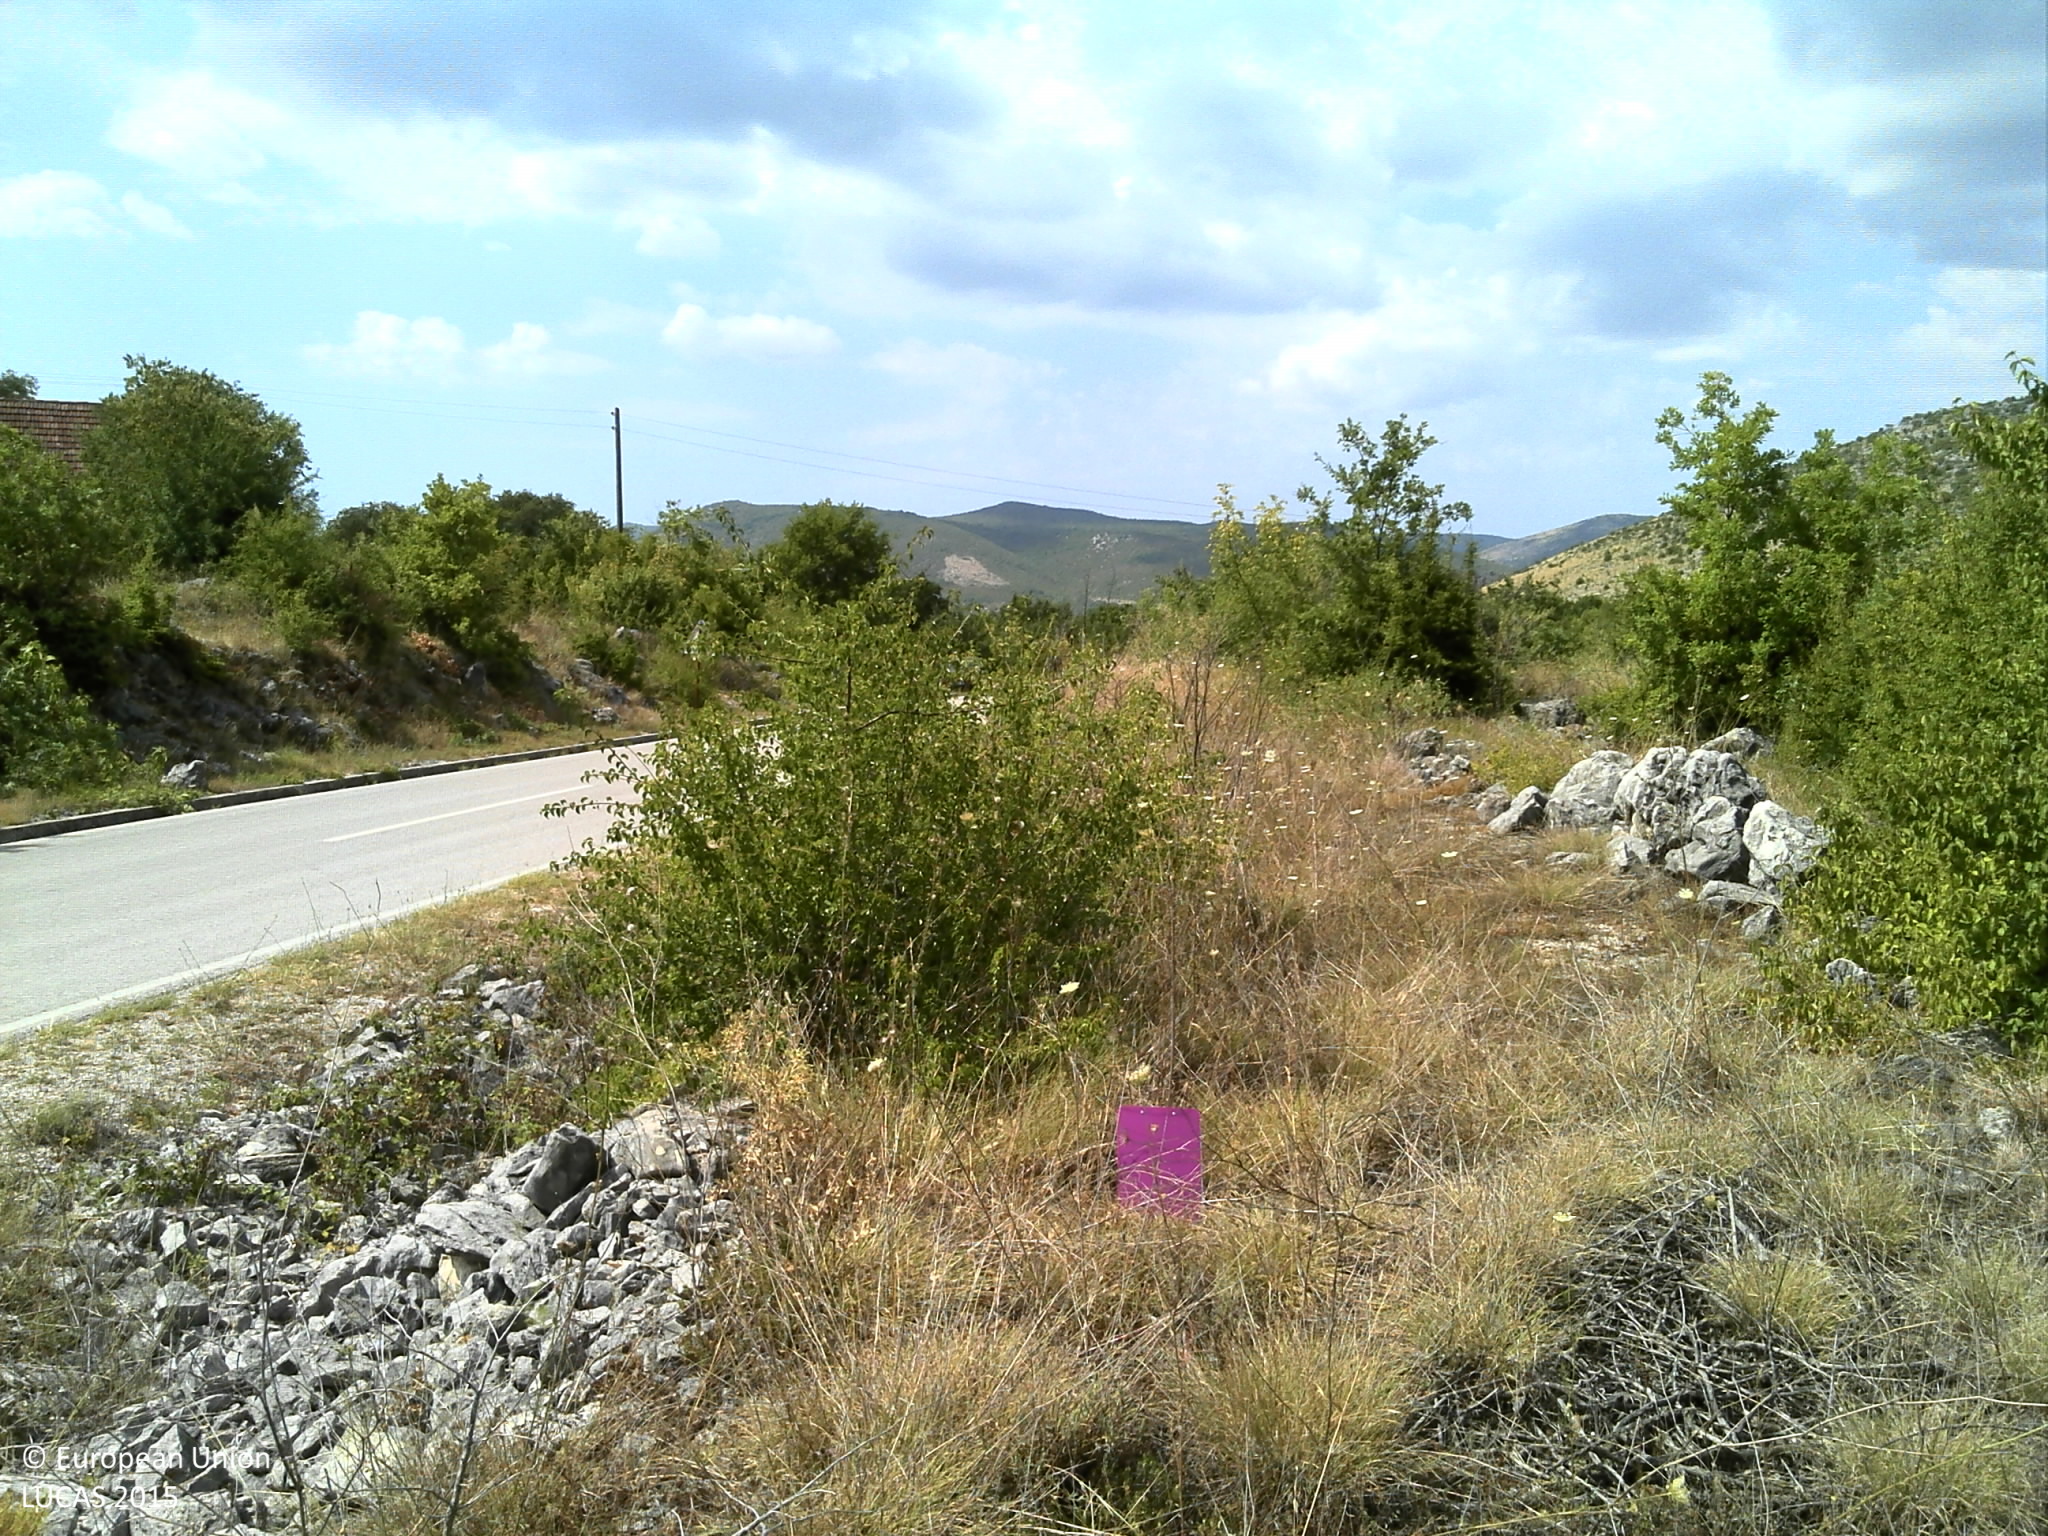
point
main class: Shrubland
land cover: Shrubland with sparse tree cover
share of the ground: 25 - 50 %
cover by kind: herbaceous plants 50 %, shrubs 20 %, unconsolidated bare surface 15 %, consolidated bare surface 10 %, broadleaved forest trees 5 %
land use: Semi-natural and natural areas not in use
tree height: < 5 m
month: July
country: HR
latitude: 43.6974
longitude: 16.1579
